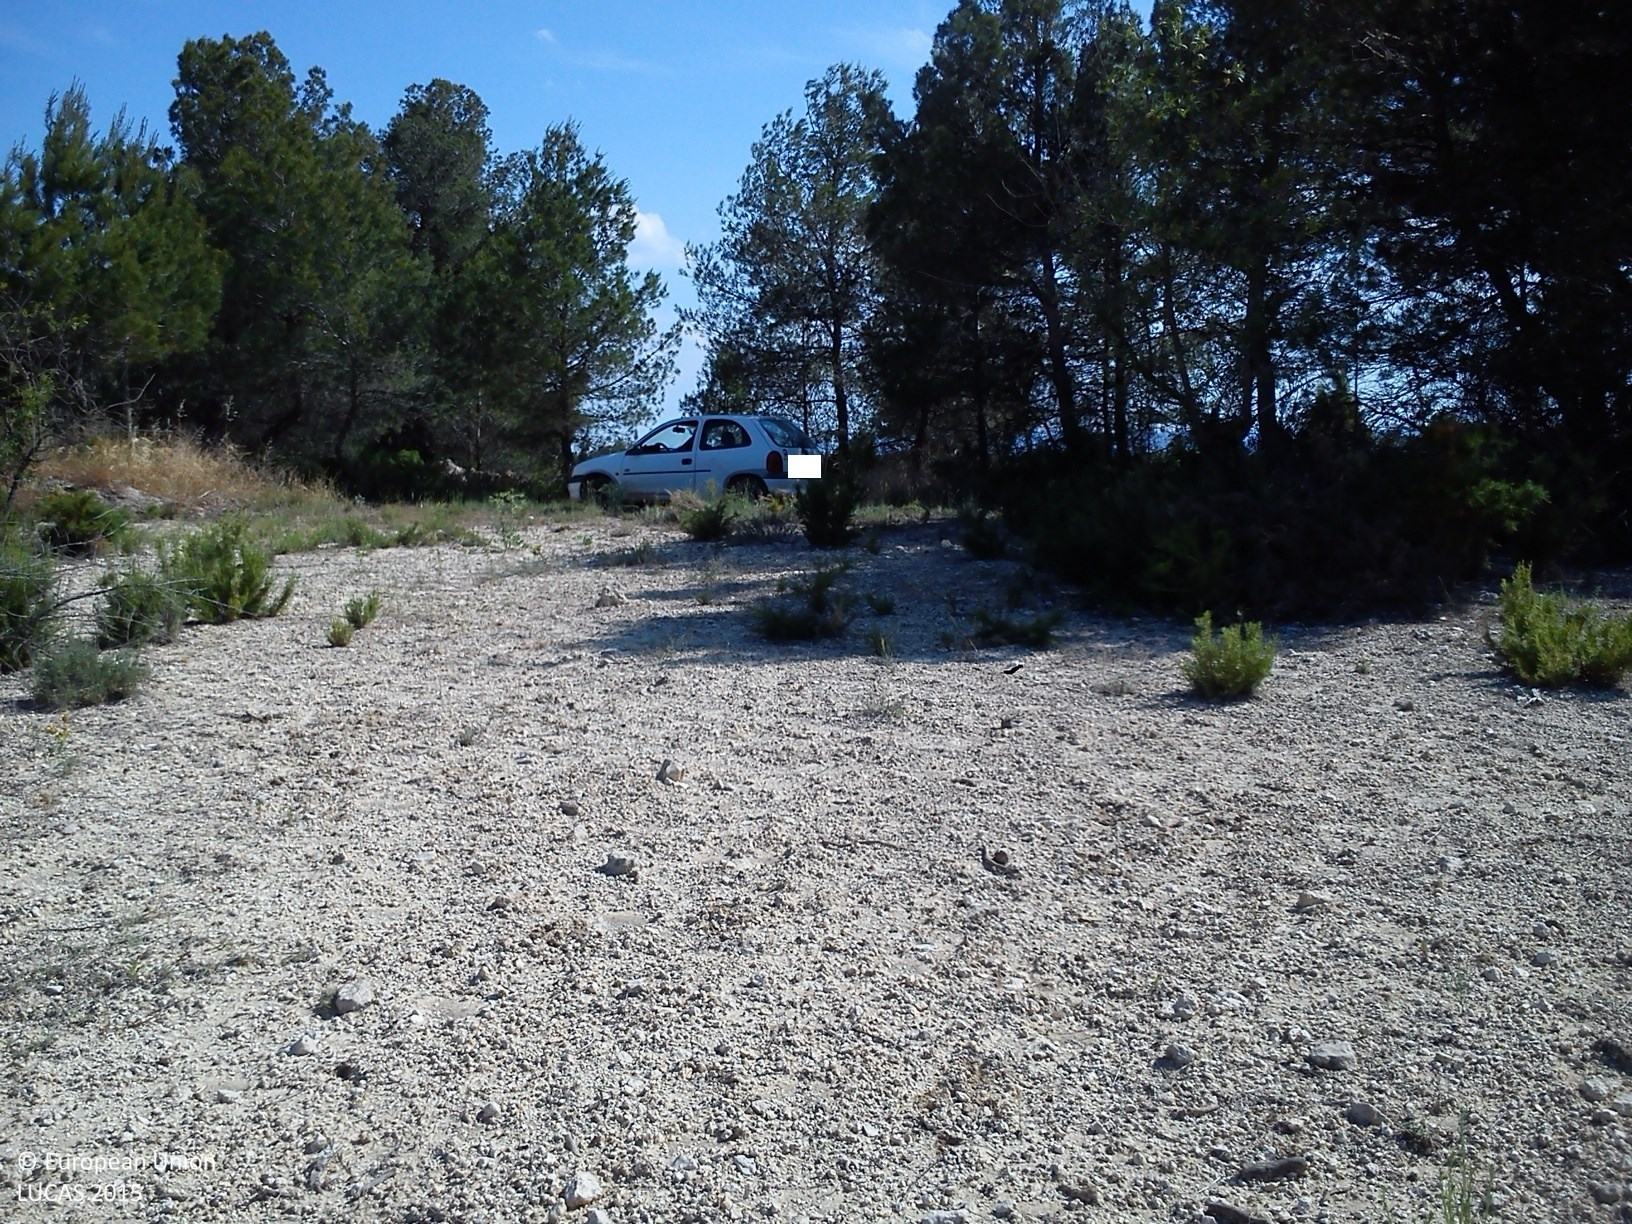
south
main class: Shrubland
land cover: Shrubland with sparse tree cover
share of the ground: 10 - 25 %
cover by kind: herbaceous plants 40 %, unconsolidated bare surface 35 %, shrubs 20 %, coniferous forest trees 5 %
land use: Abandoned areas
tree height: < 5 m
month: June
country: ES
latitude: 39.3098
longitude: -1.0746
